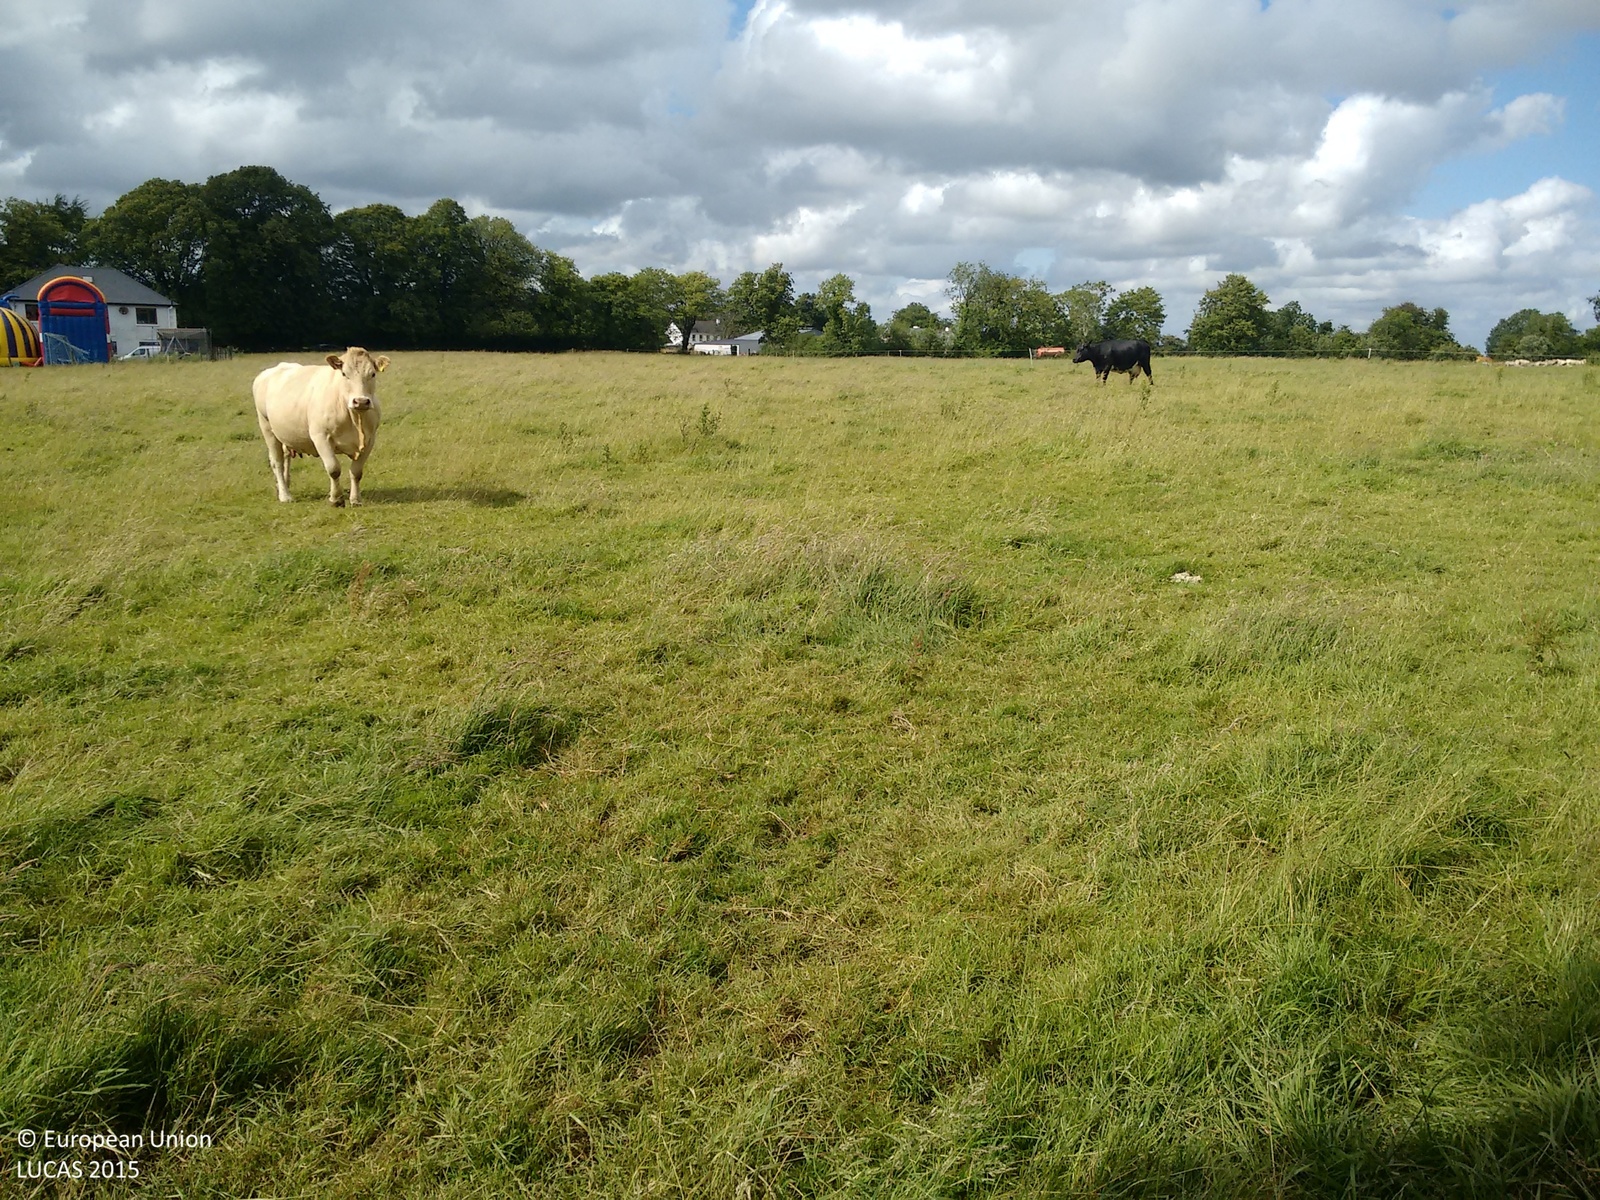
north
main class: Grassland
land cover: Grassland with sparse tree/shrub cover
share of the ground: > 75 %
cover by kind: herbaceous plants 95 %, broadleaved forest trees 5 %
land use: Agriculture (excluding fallow land and kitchen gardens)
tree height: > 5 m
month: July
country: IE
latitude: 53.6240
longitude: -7.6252
